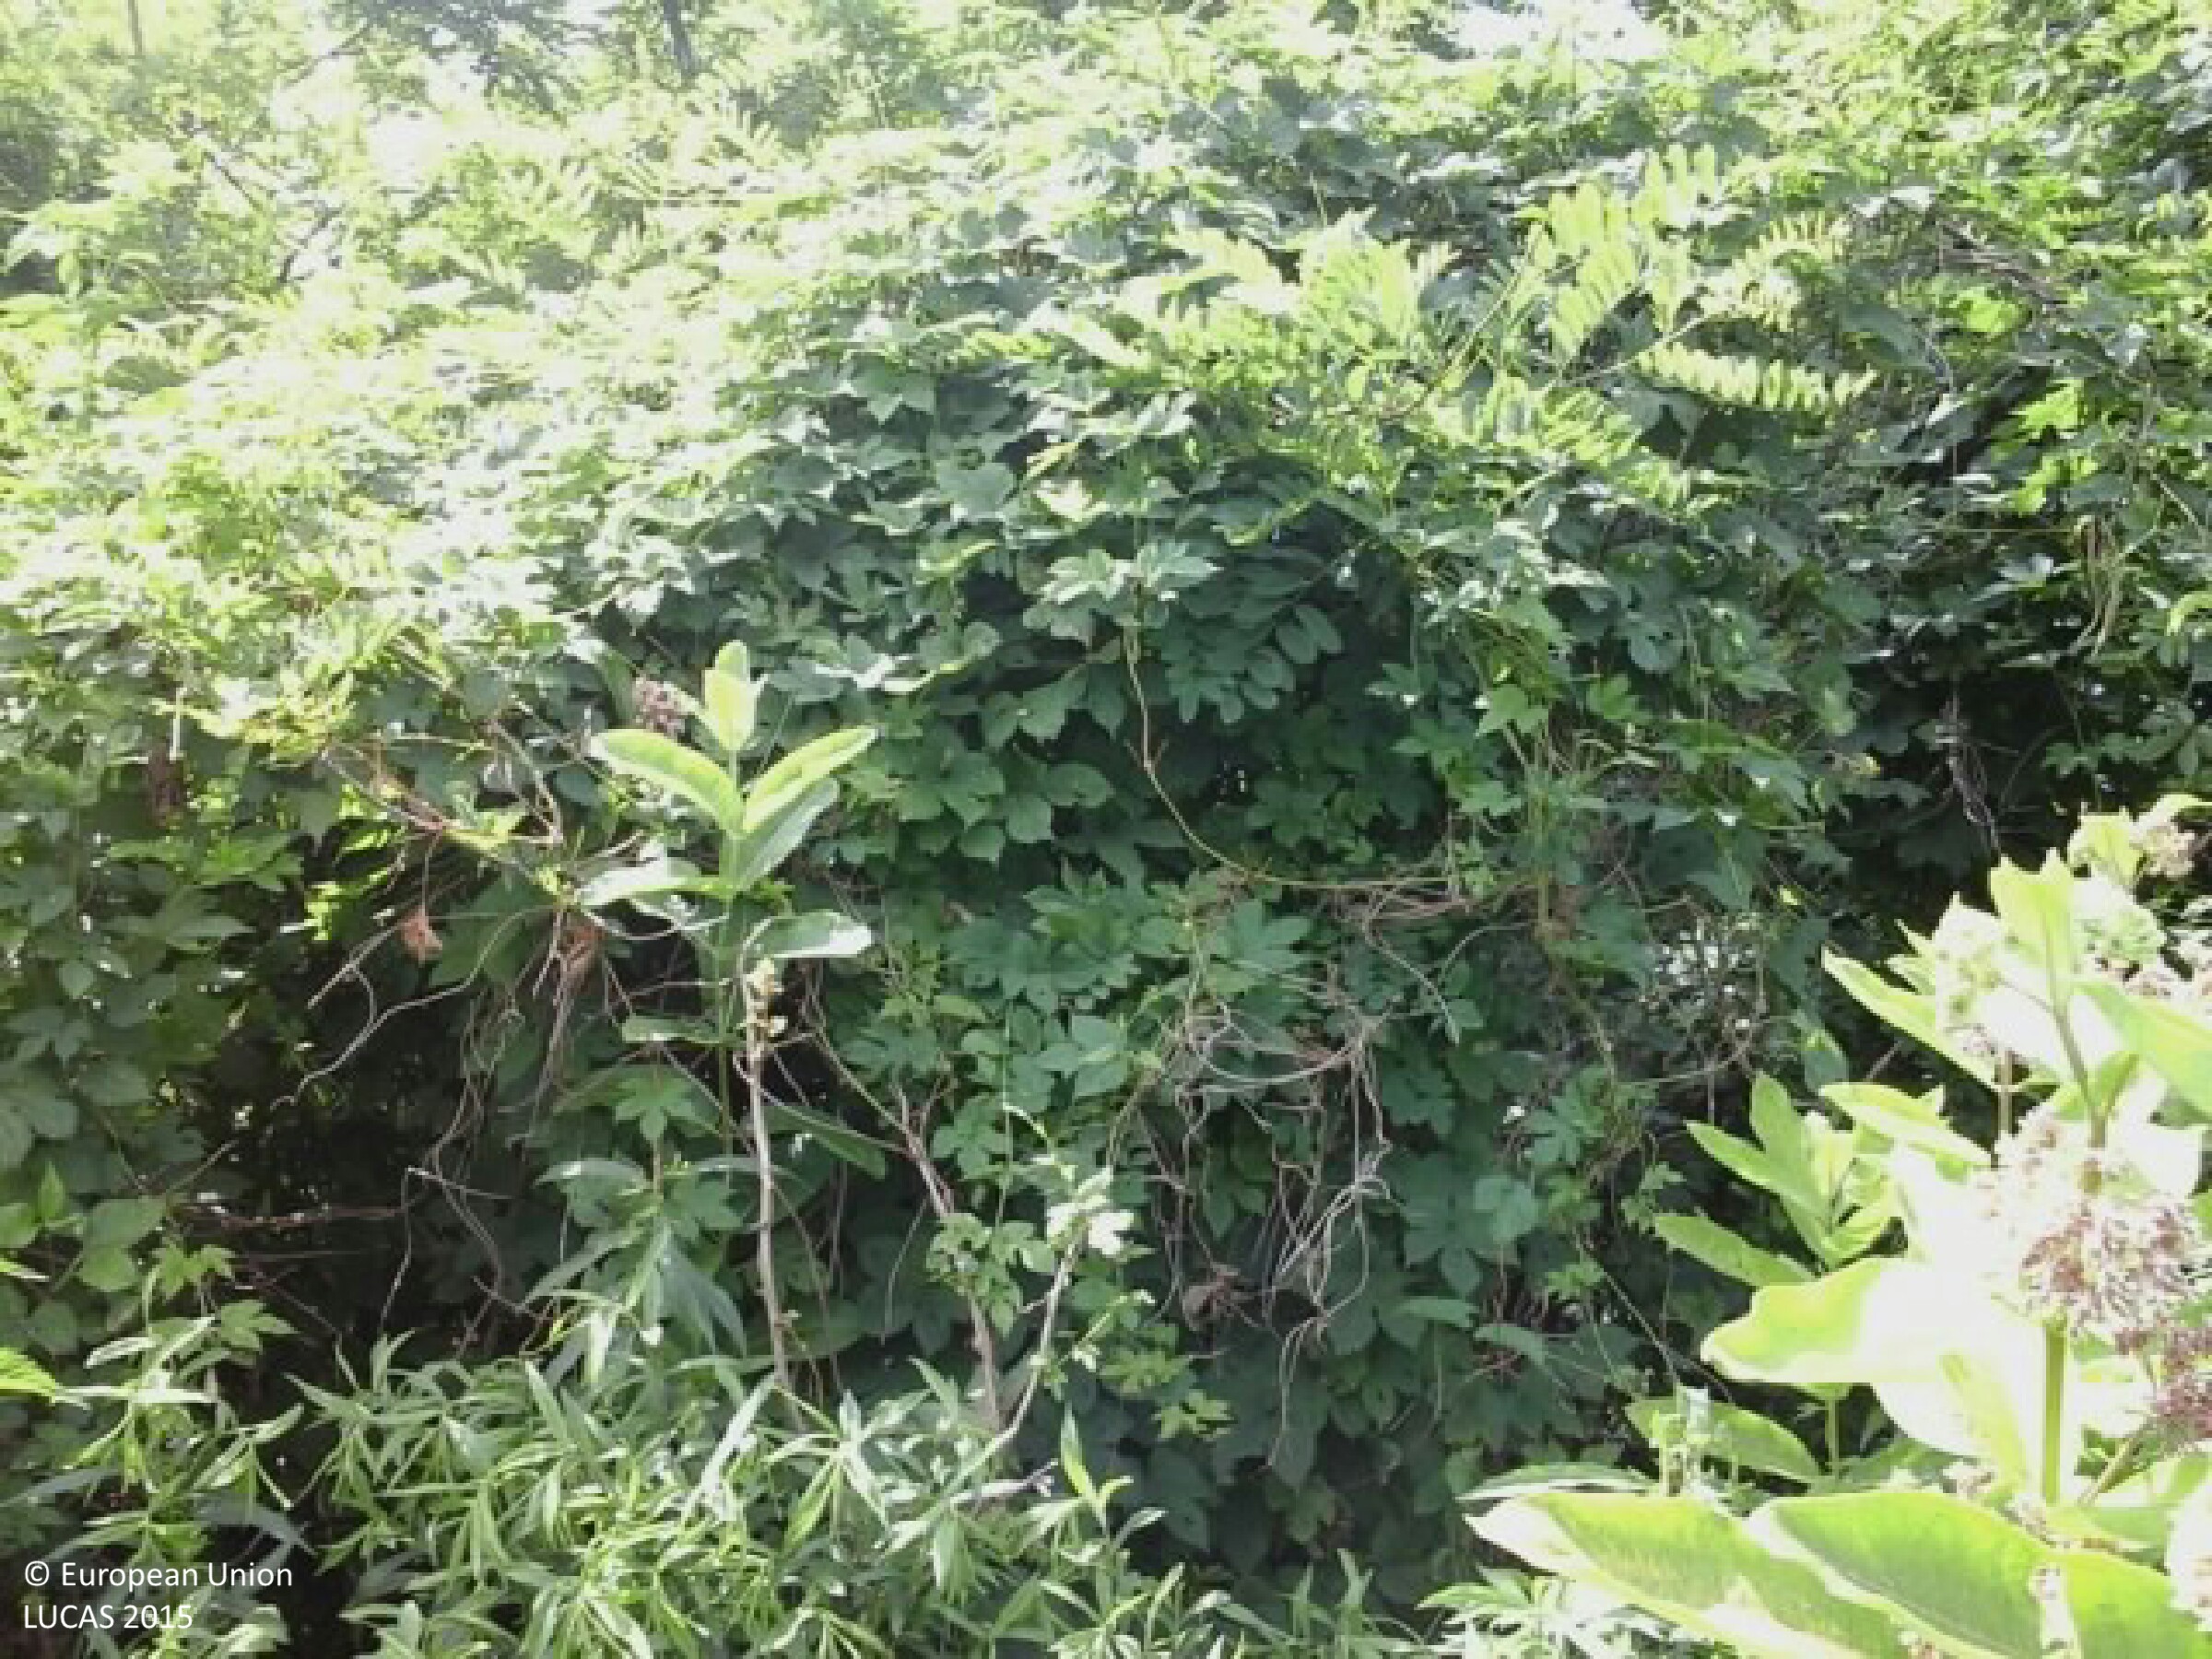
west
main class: Shrubland
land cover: Shrubland with sparse tree cover
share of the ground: > 75 %
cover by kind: shrubs 65 %, herbaceous plants 30 %, broadleaved forest trees 5 %
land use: Semi-natural and natural areas not in use
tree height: > 5 m
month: June
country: HU
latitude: 47.5371
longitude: 19.3327
